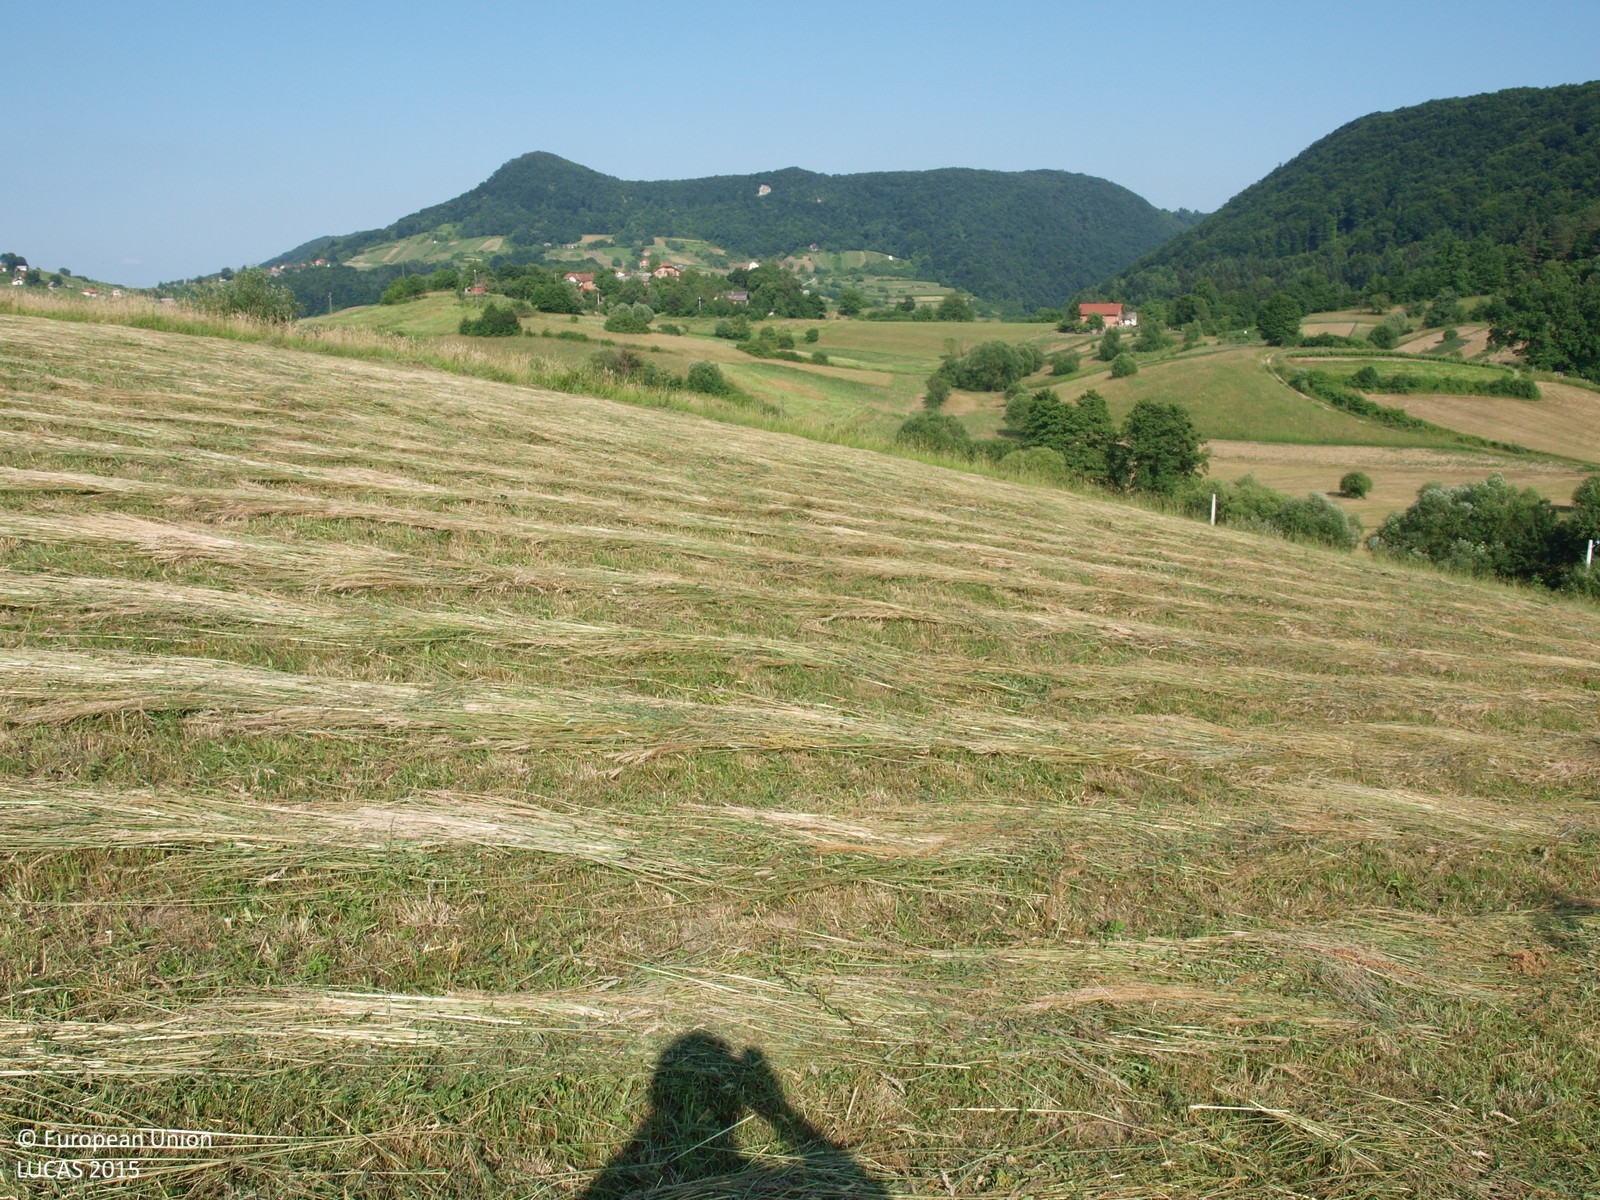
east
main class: Cropland
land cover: Nuts trees
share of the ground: 50 - 75 %
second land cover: Grassland without tree/shrub cover
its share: 50 - 75 %
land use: Agriculture (excluding fallow land and kitchen gardens)
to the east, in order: Nuts trees; Grassland without tree/shrub cover; Fences; Grassland without tree/shrub cover; Maize; Grass margins; Maize; Shrubland without tree cover; Paved roads, cycling and walking lanes; Grass margins; Maize; Rivers and streams; Grassland without tree/shrub cover; Electric lines; Grassland without tree/shrub cover; Electric lines; Grassland without tree/shrub cover
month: June
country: HR
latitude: 46.2906
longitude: 16.0092
